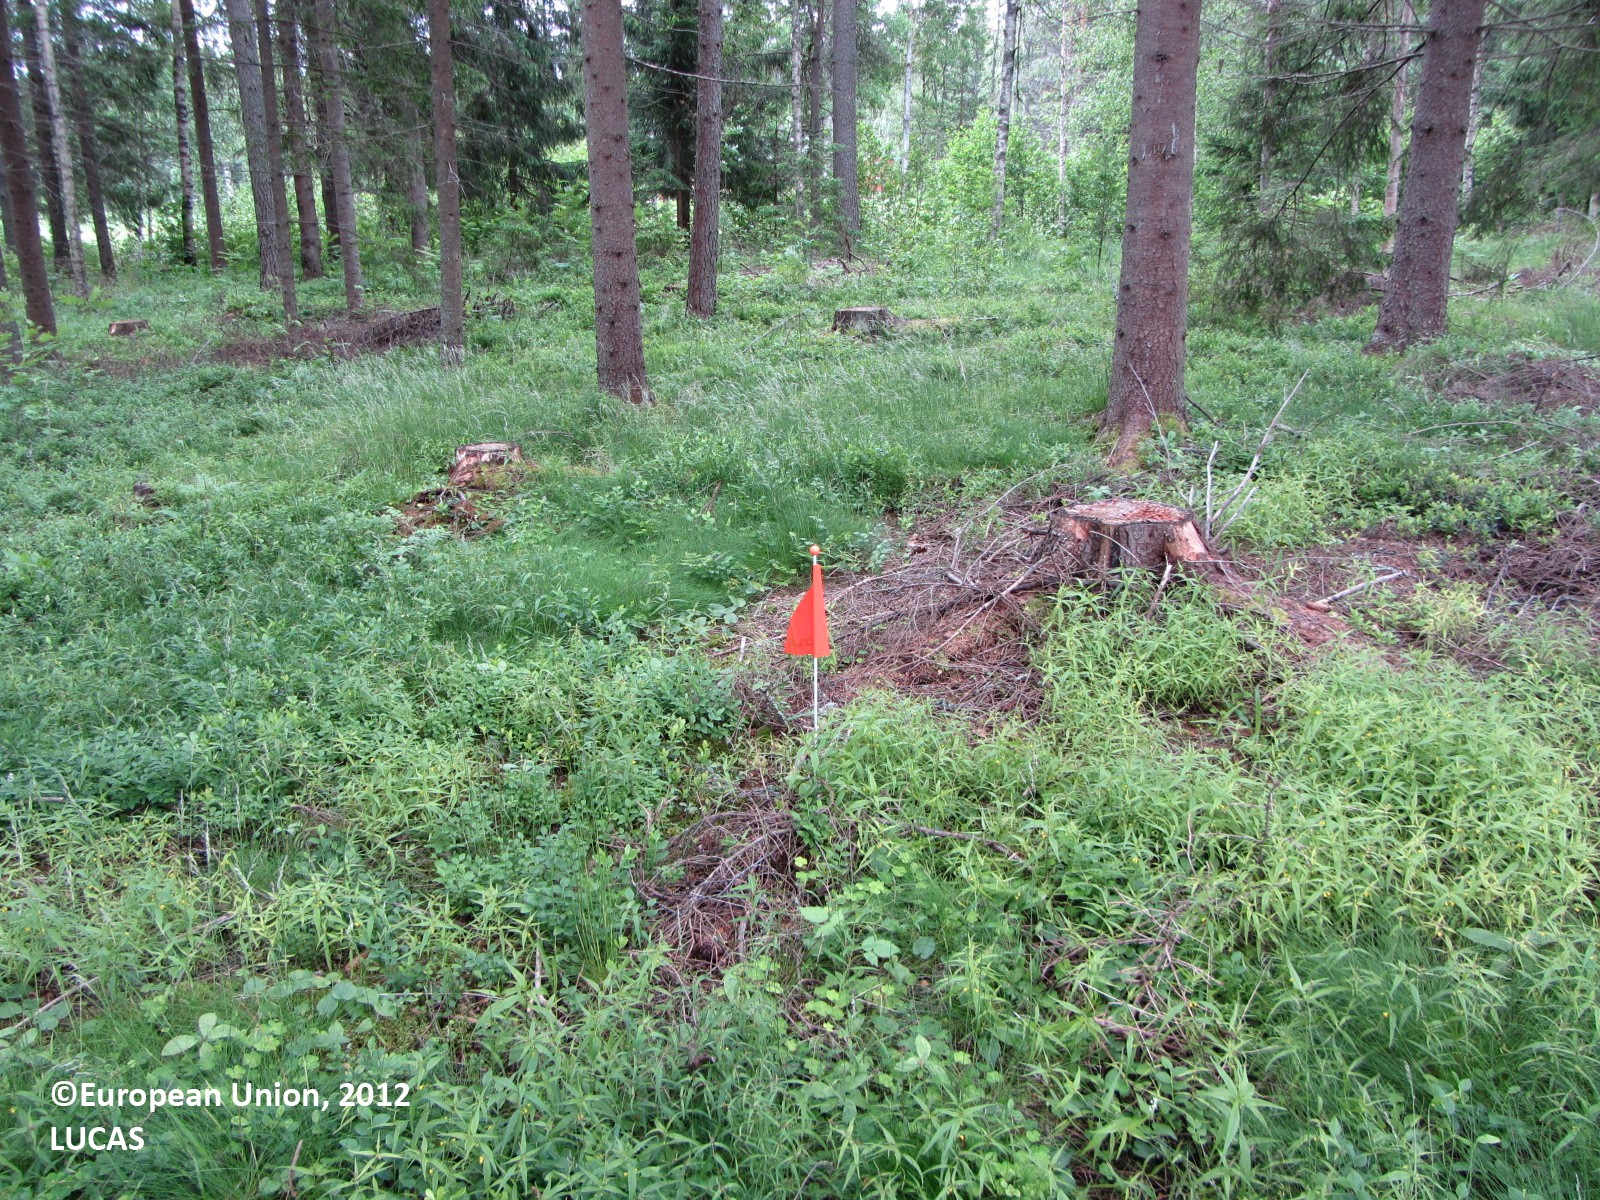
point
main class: Woodland
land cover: Spruce dominated mixed woodland
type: boreal forest
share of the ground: 50 - 75 %
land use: Forestry
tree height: > 5 m
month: June
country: FI
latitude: 62.5940
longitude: 25.5150
